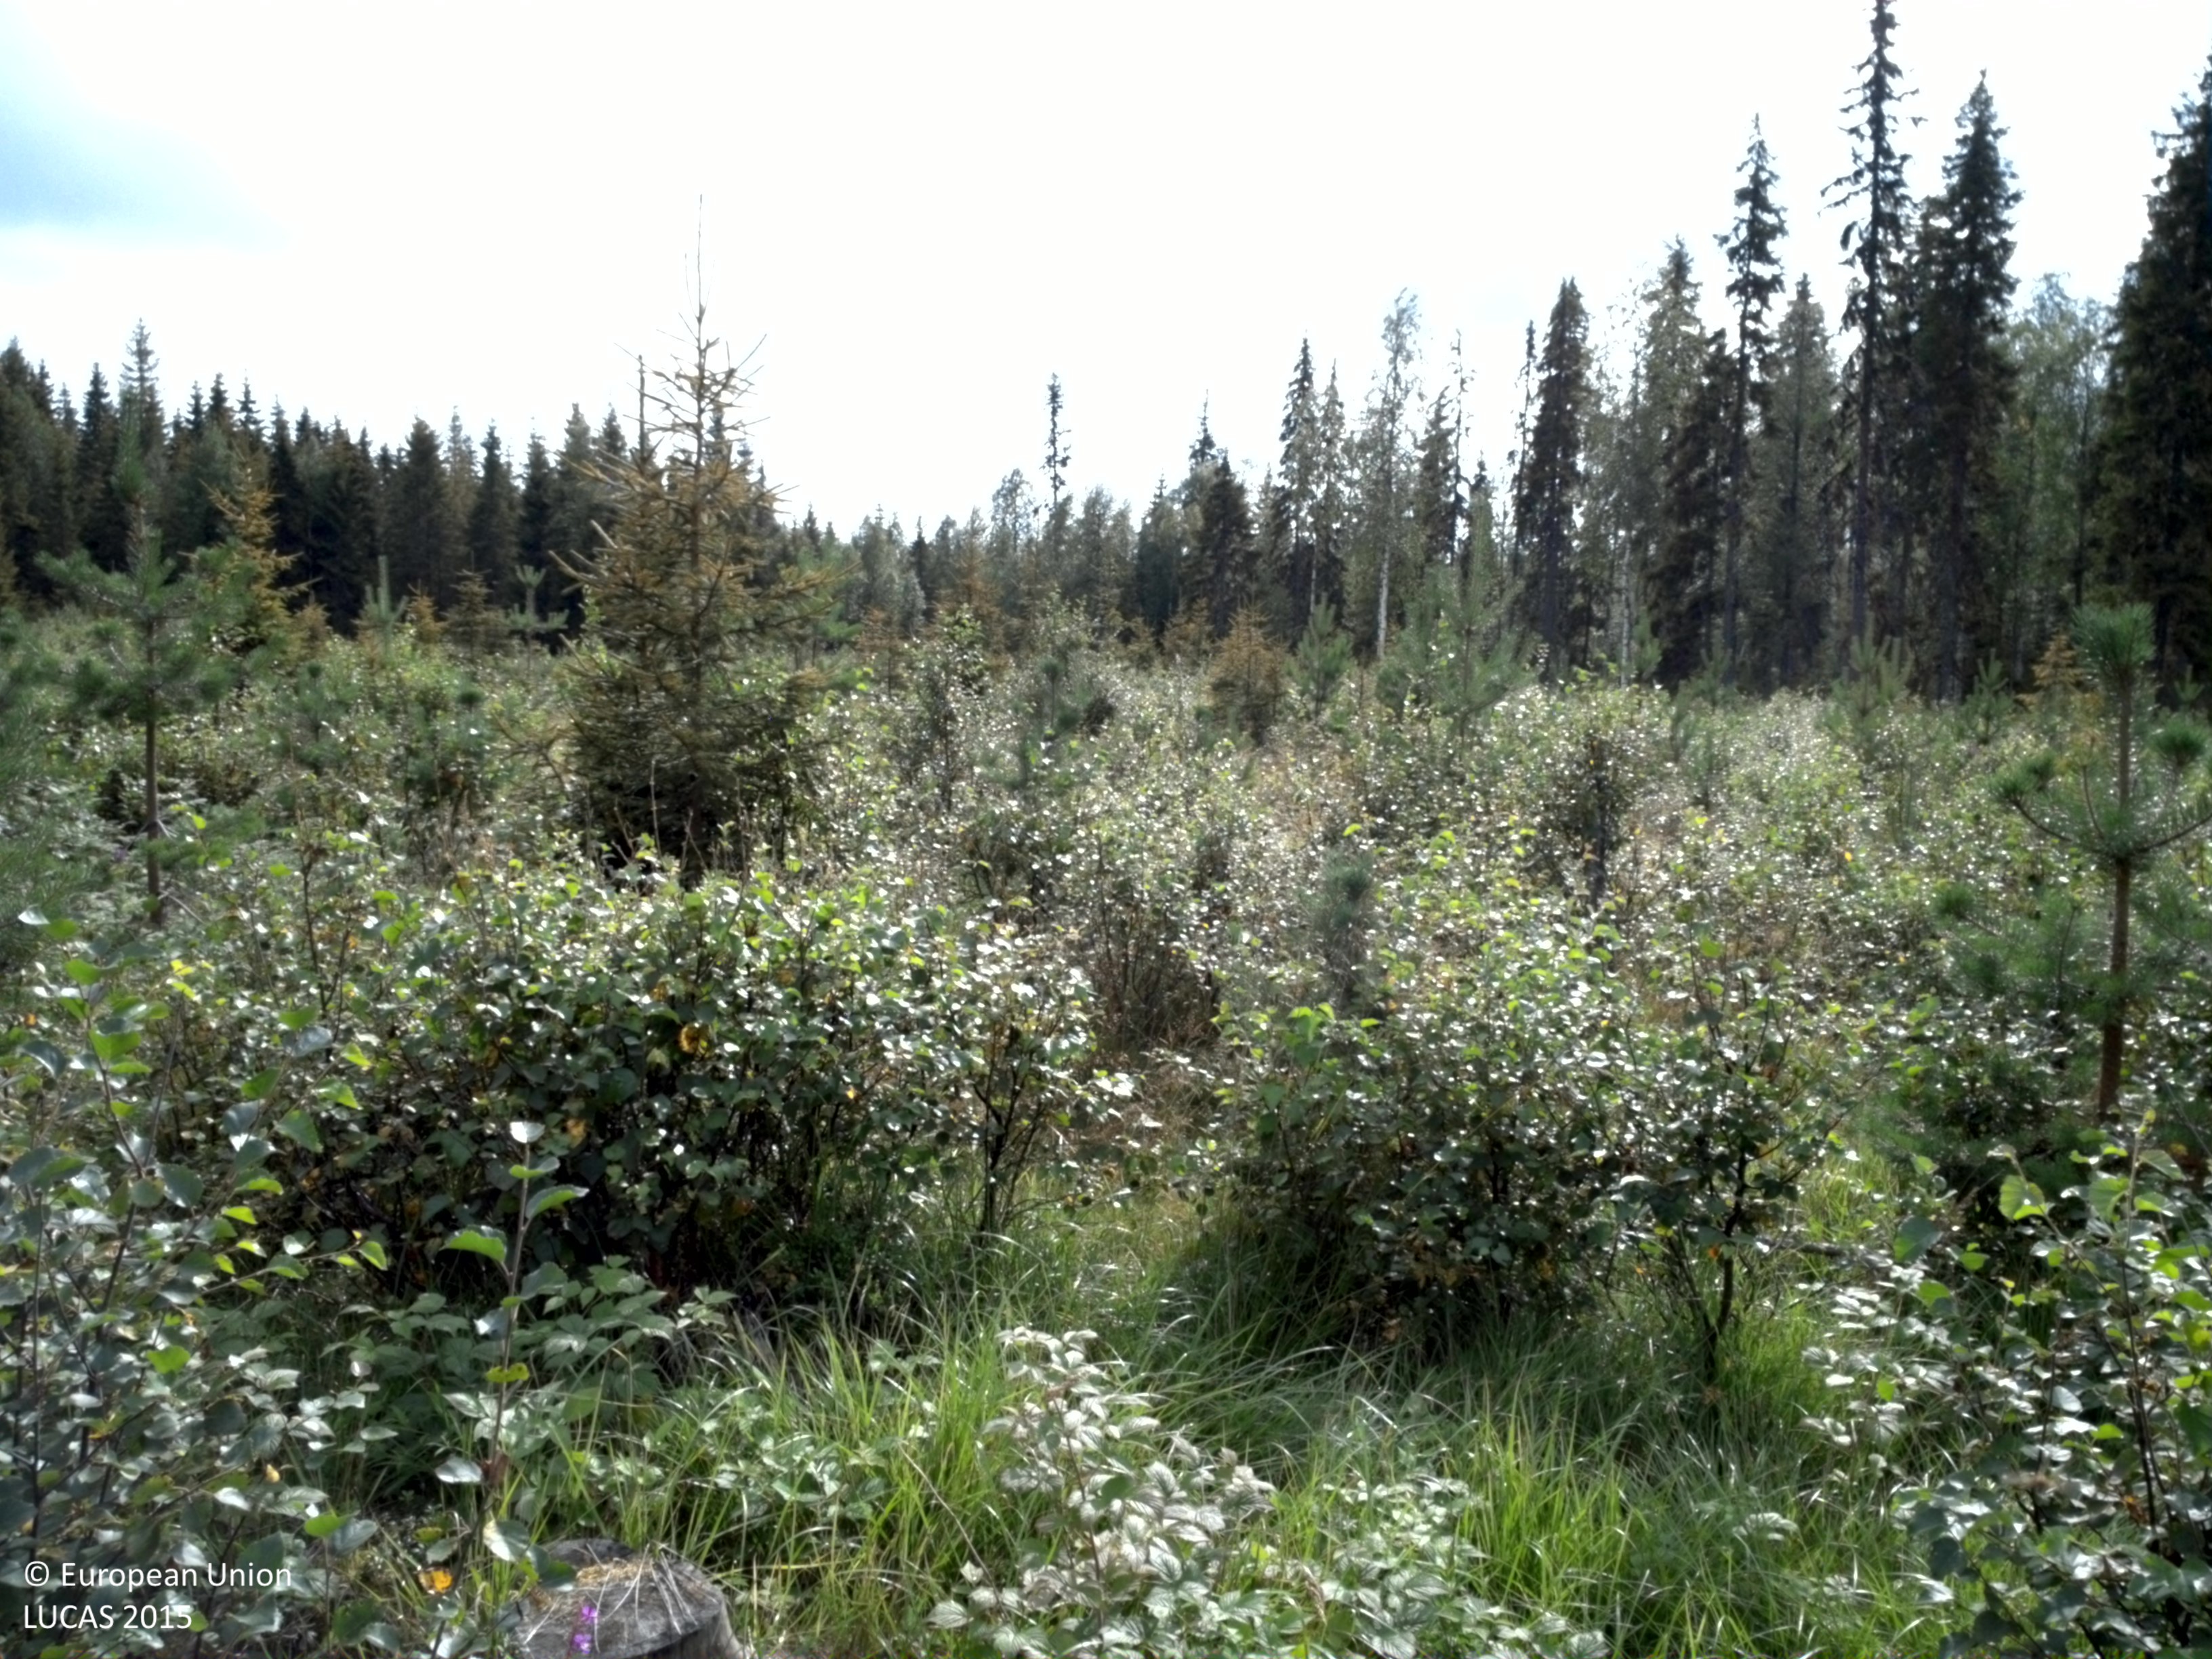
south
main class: Woodland
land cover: Other mixed woodland
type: boreal forest
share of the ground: 50 - 75 %
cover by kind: broadleaved forest trees 35 %, shrubs 35 %, coniferous forest trees 15 %, herbaceous plants 15 %
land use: Forestry
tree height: < 5 m
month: August
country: SE
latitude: 65.9830
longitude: 22.6408
